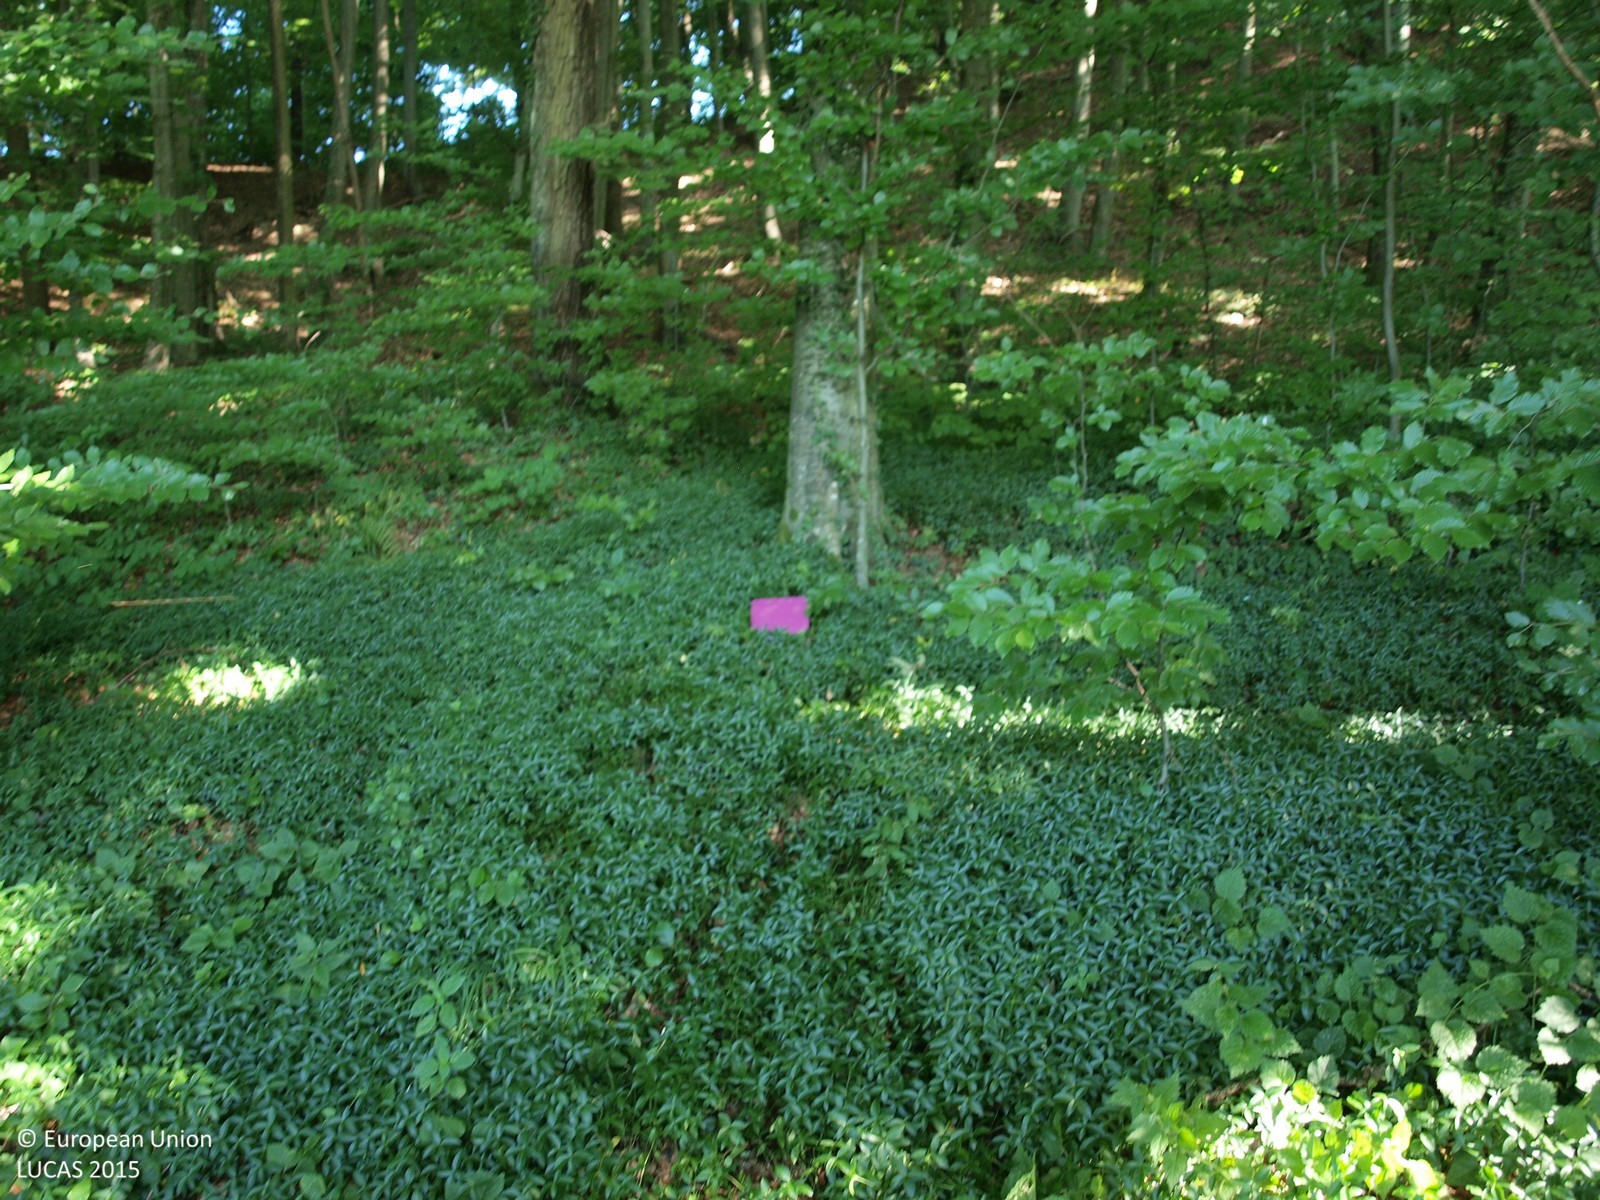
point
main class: Woodland
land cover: Broadleaved woodland
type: beech forest
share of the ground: > 75 %
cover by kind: broadleaved forest trees 100 %
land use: Forestry
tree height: > 5 m
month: July
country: HR
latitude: 45.9704
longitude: 15.9218
